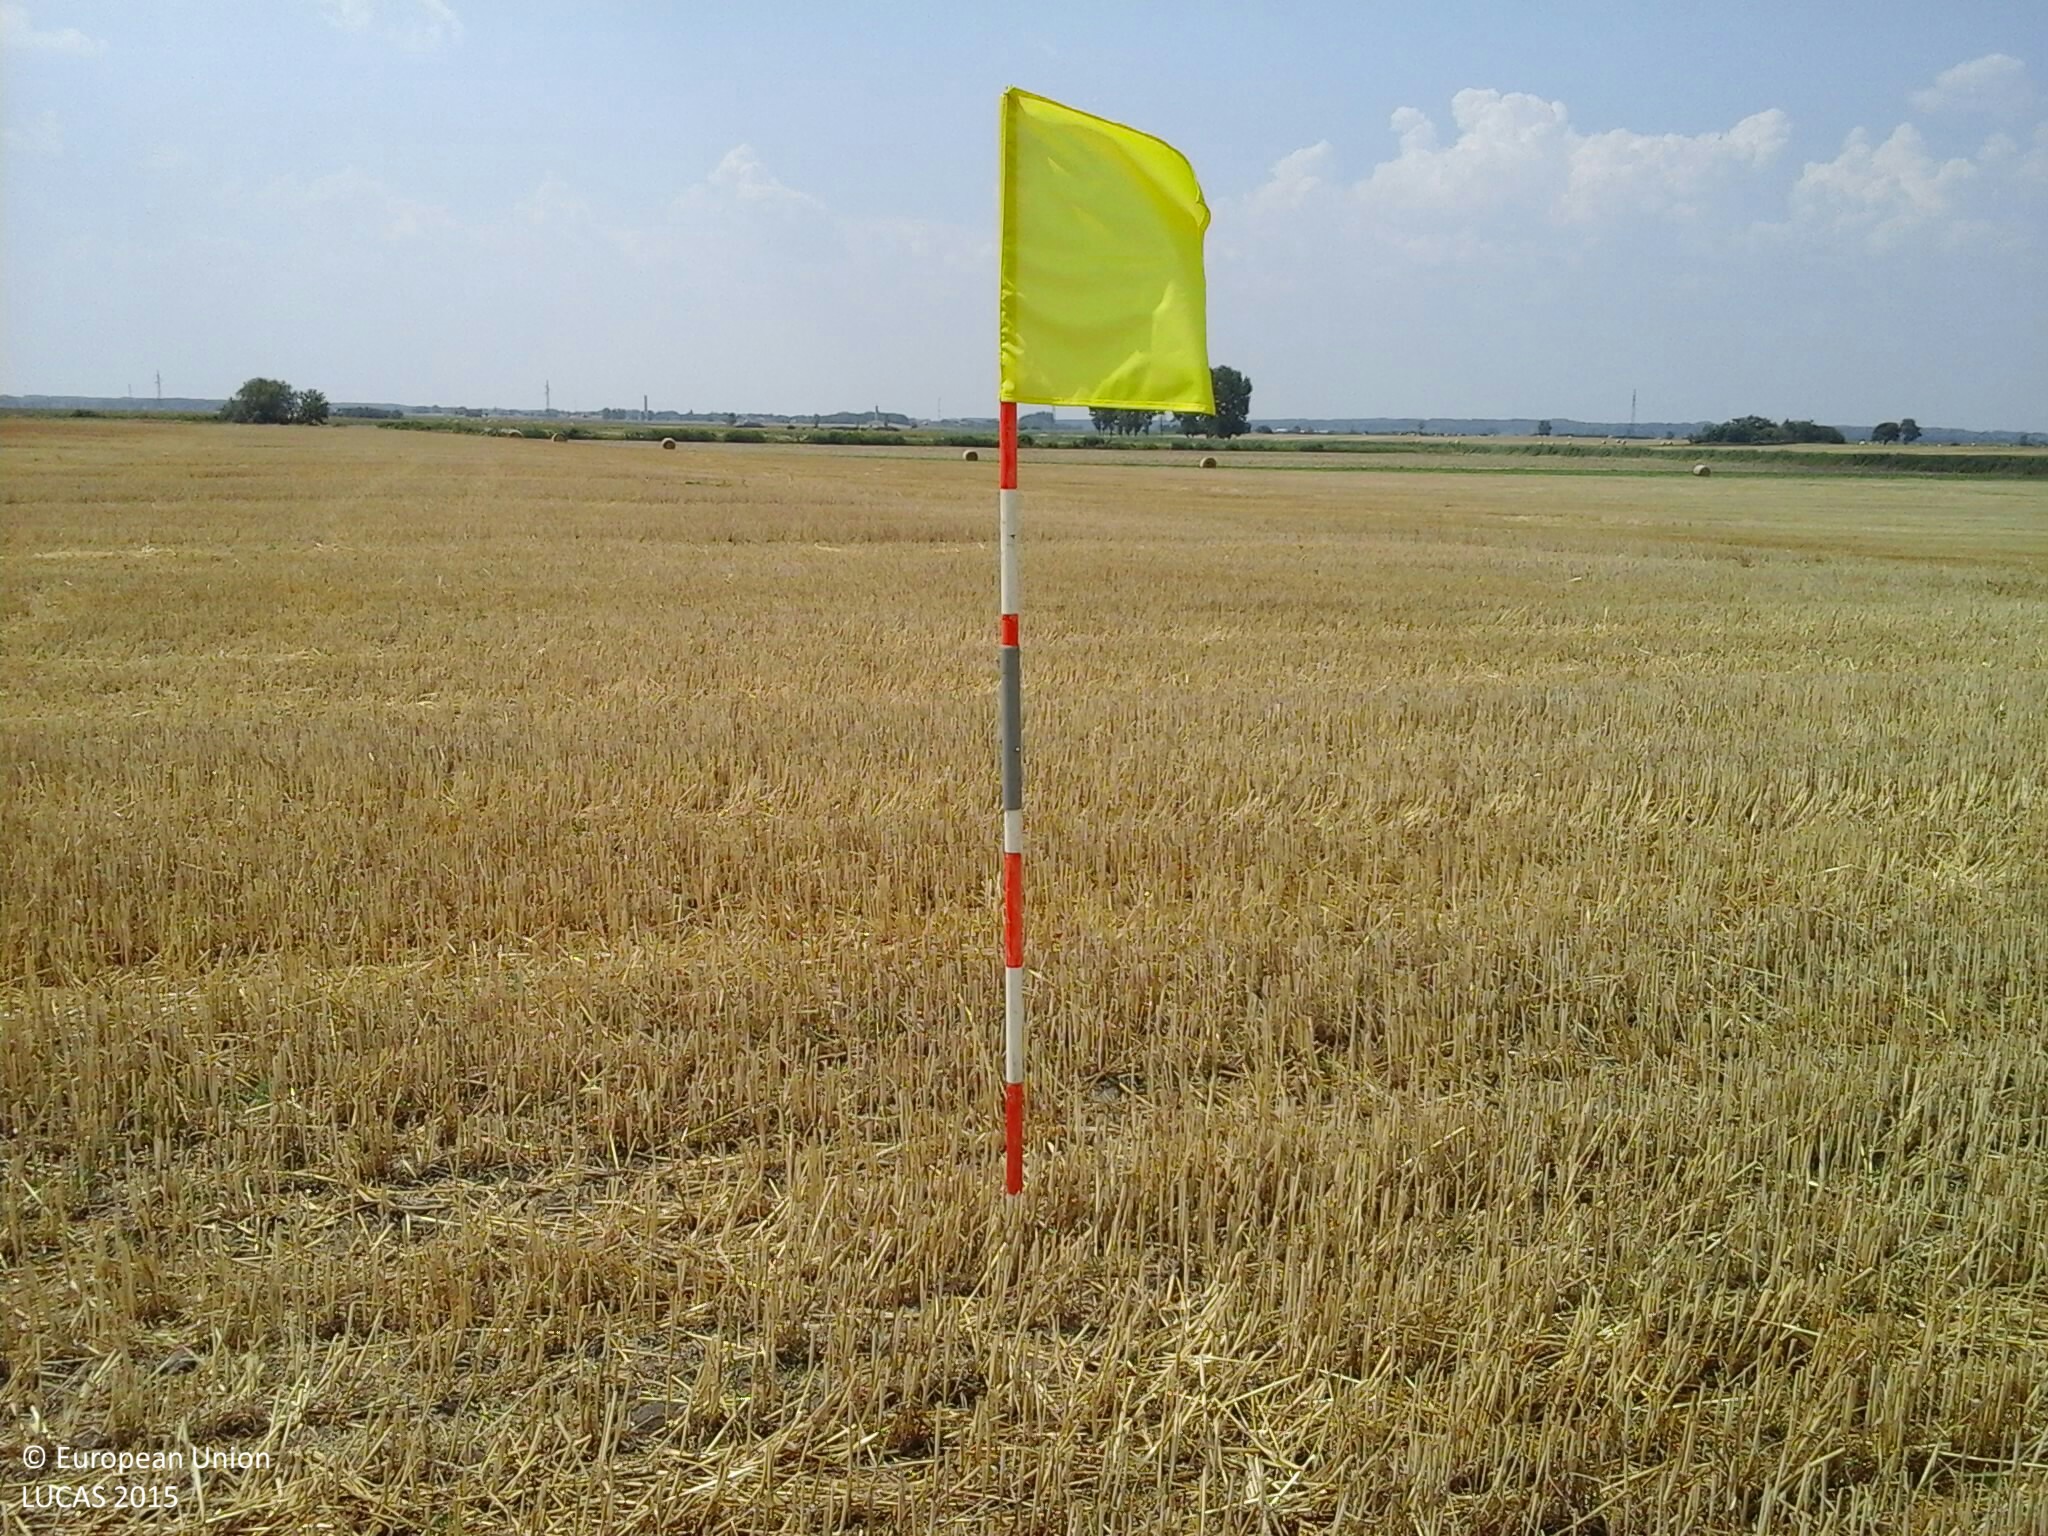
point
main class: Cropland
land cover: Common wheat
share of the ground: 25 - 50 %
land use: Agriculture (excluding fallow land and kitchen gardens)
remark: Harvested field
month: July
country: HU
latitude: 47.7016
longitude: 21.0590
